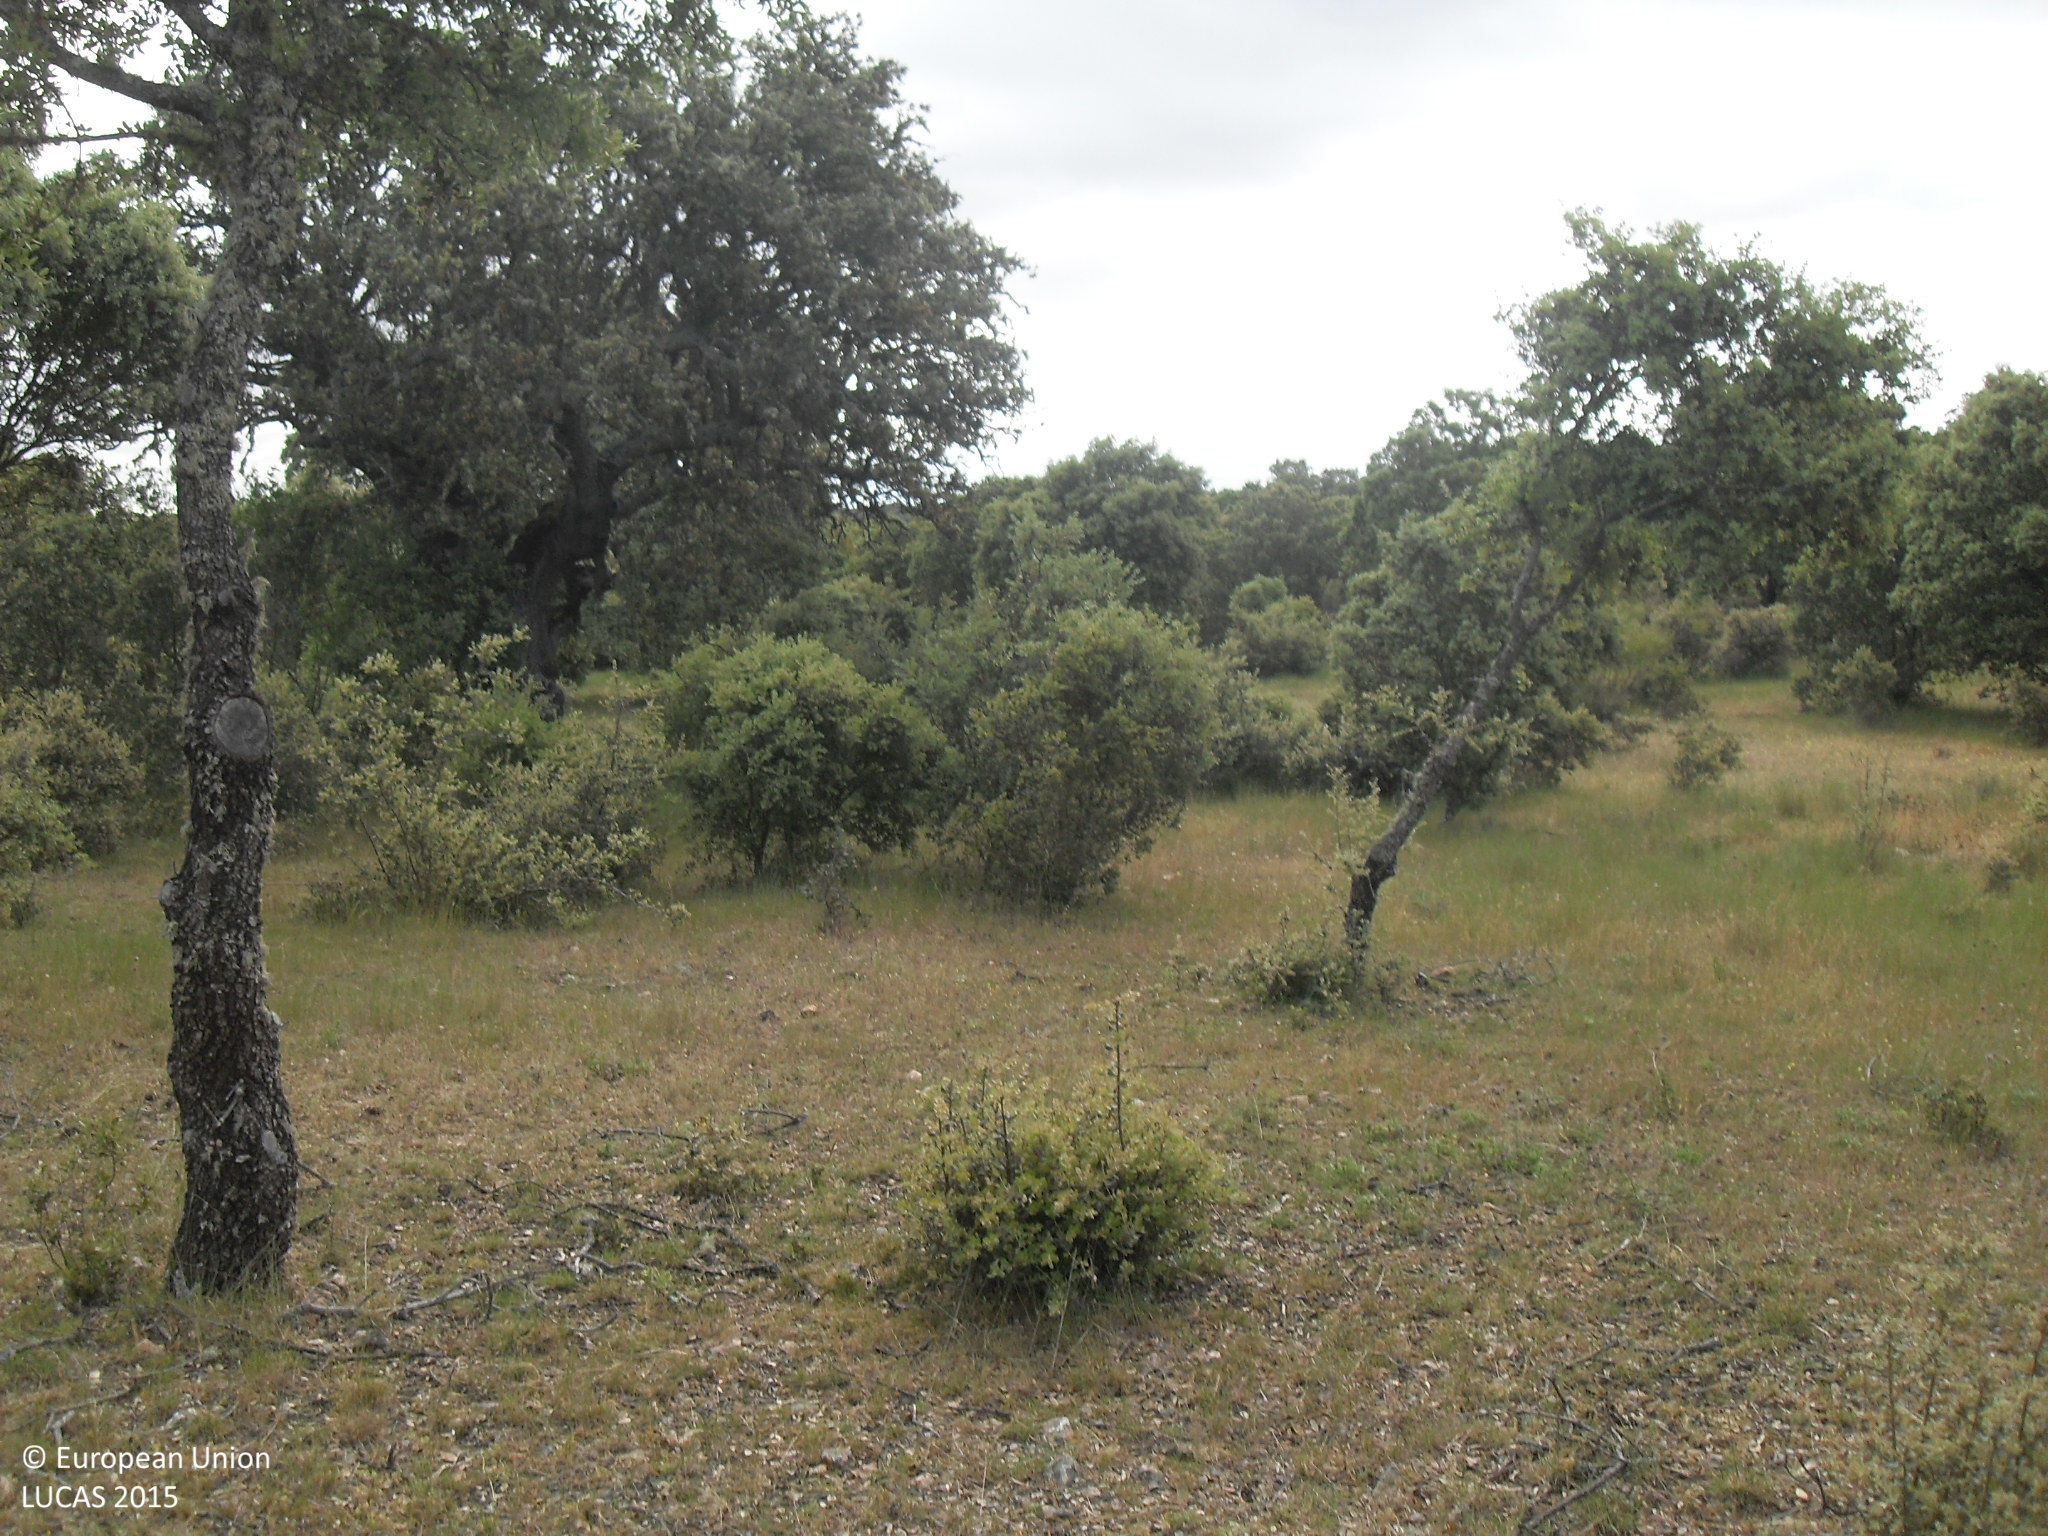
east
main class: Woodland
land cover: Broadleaved woodland
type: broadleaved evergreen forest
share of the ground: > 75 %
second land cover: Grassland without tree/shrub cover
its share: 10 - 25 %
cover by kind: broadleaved forest trees 80 %, herbaceous plants 20 %
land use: Forestry
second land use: Agriculture (excluding fallow land and kitchen gardens)
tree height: > 5 m
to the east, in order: Broadleaved woodland; Grassland without tree/shrub cover; Fences; Broadleaved woodland
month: May
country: ES
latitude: 40.7317
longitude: -5.6438
